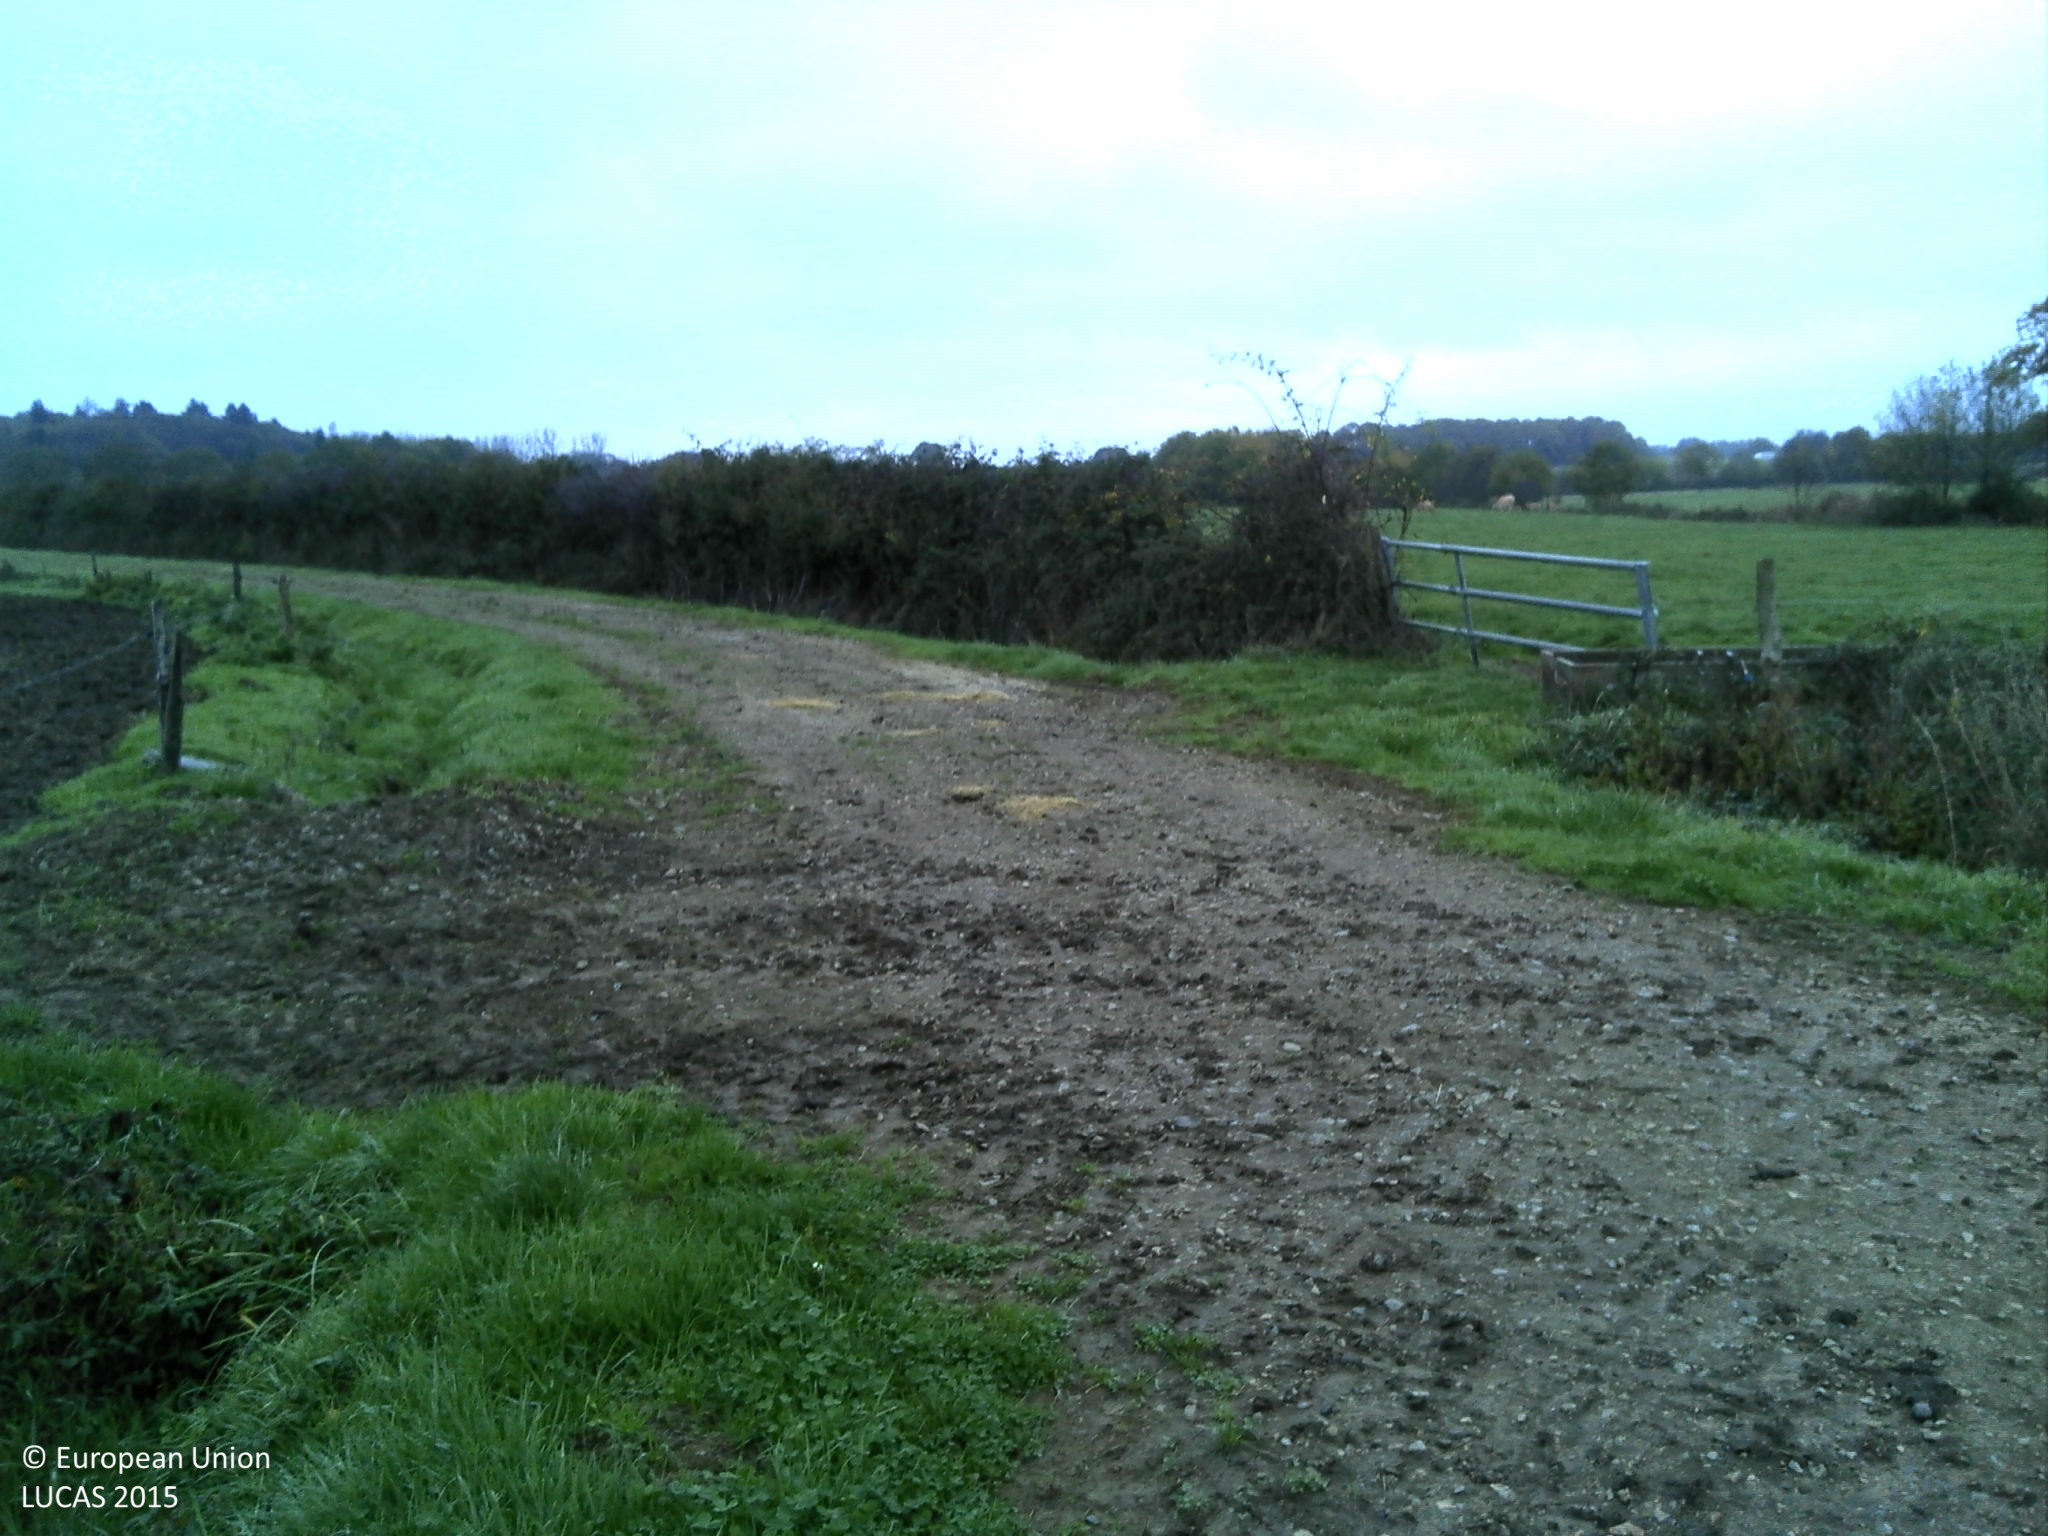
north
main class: Grassland
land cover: Grassland without tree/shrub cover
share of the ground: > 75 %
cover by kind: herbaceous plants 100 %
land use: Agriculture (excluding fallow land and kitchen gardens)
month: November
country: FR
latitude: 47.6867
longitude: -1.3795
